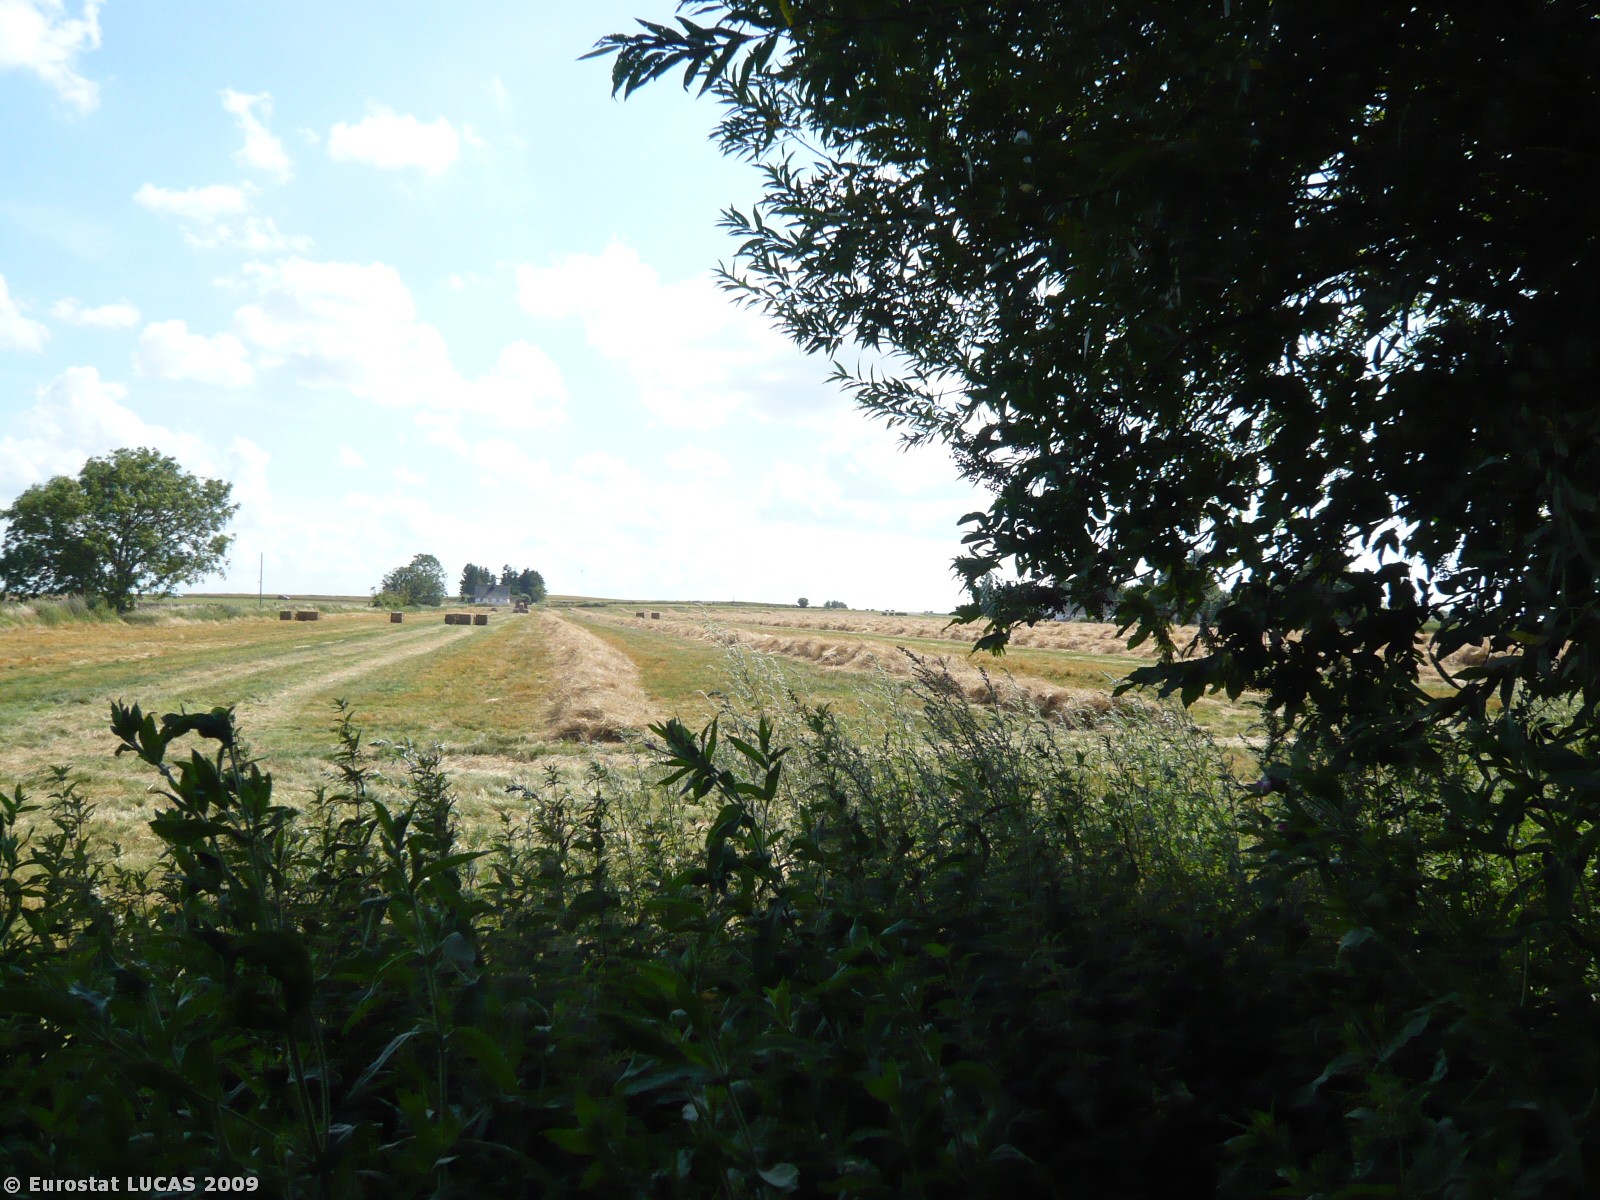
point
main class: Grassland
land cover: Grassland without tree/shrub cover
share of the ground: > 75 %
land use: Agriculture (excluding fallow land and kitchen gardens)
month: July
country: DK
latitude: 55.7809
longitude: 11.7044
